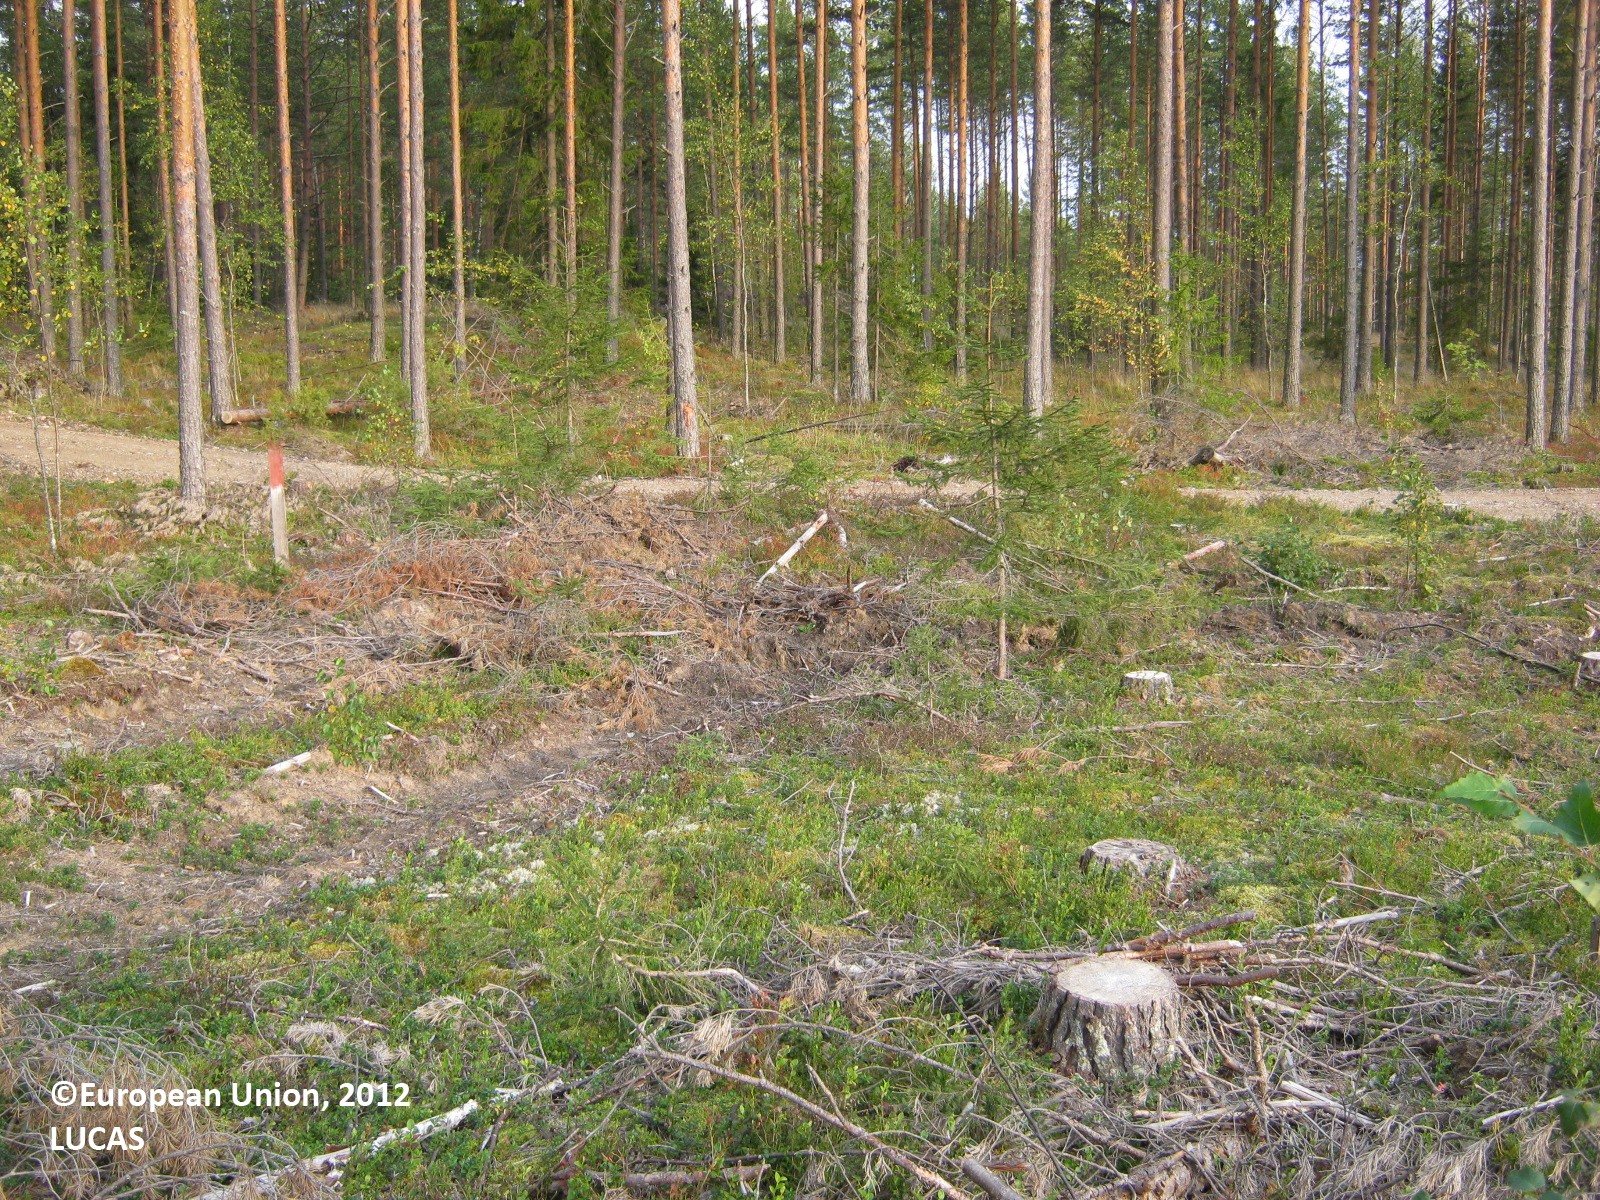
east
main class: Shrubland
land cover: Shrubland with sparse tree cover
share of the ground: > 75 %
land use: Forestry
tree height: < 5 m
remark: Clear cut
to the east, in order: Shrubland with sparse tree cover; Tracks; Pine dominated coniferous woodland; Grass margins; Tracks; Grass margins; Pine dominated coniferous woodland
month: September
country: FI
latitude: 60.7568
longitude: 28.0965
